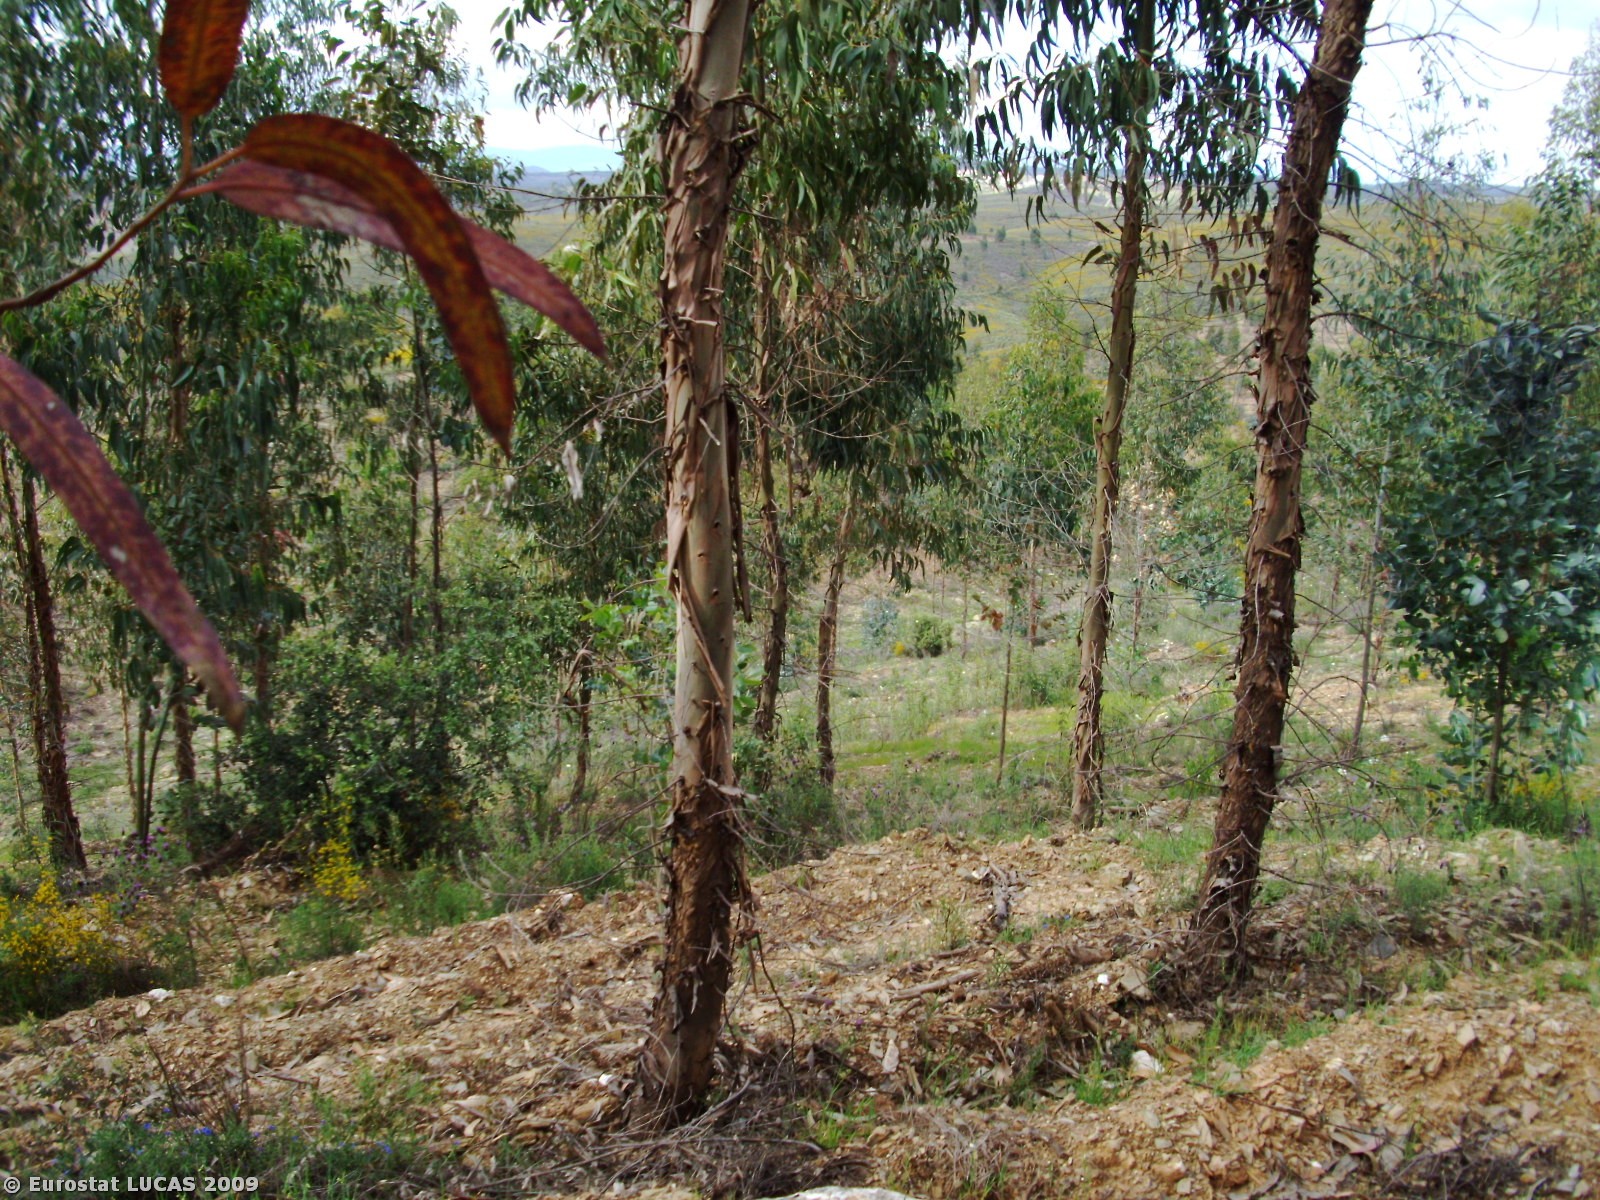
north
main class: Woodland
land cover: Broadleaved woodland
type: plantations and self-sown exotic forest
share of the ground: 25 - 50 %
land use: Forestry
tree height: > 5 m
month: April
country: PT
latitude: 39.8092
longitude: -7.5873
